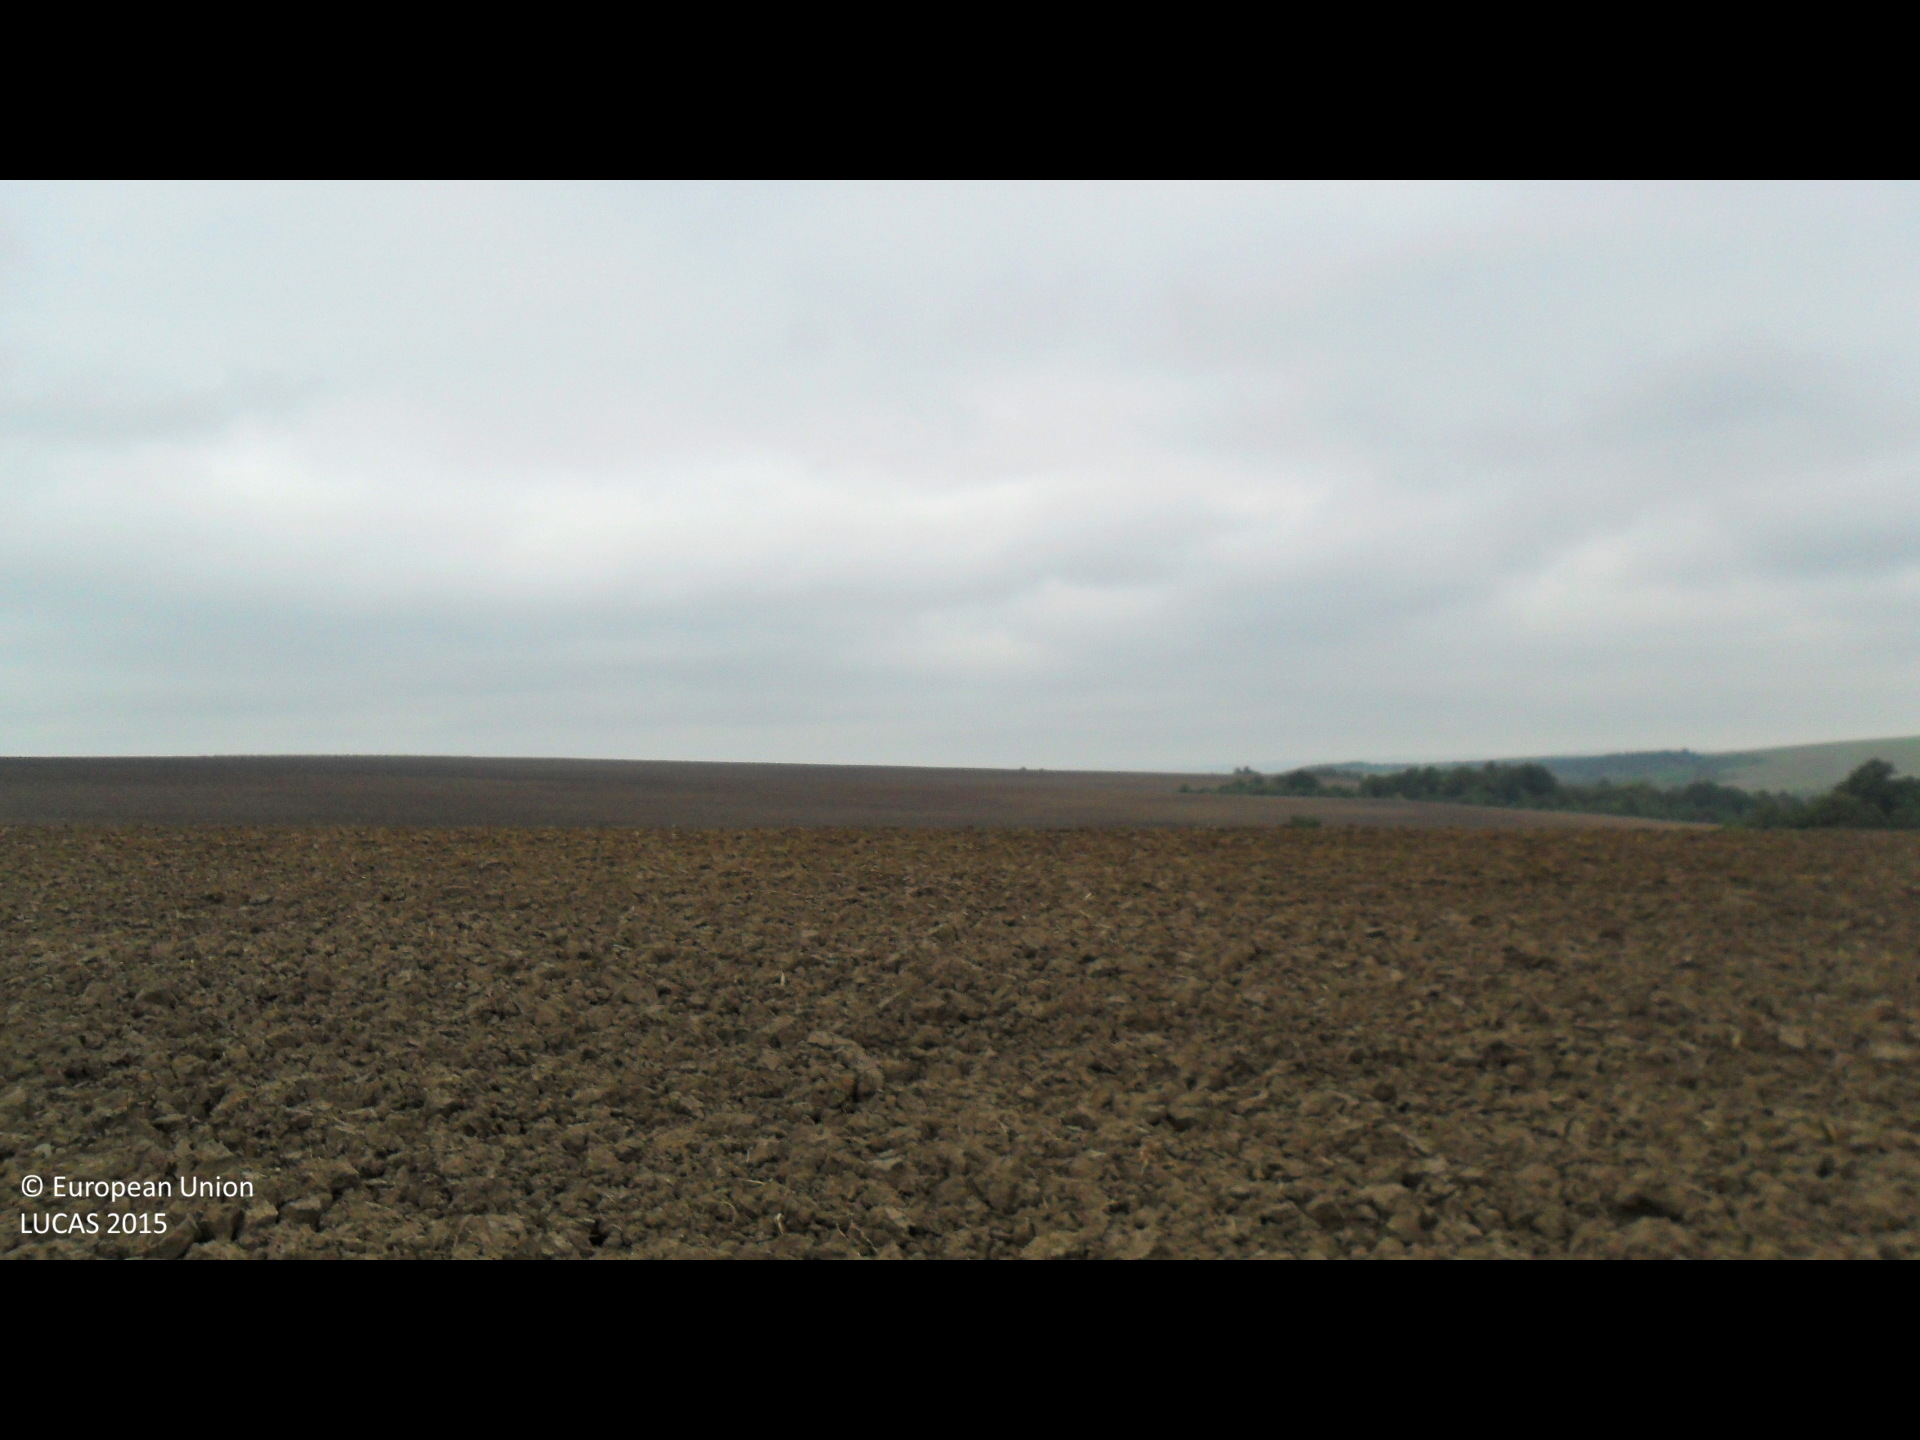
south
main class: Cropland
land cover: Maize
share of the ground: < 10 %
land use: Agriculture (excluding fallow land and kitchen gardens)
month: September
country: BG
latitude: 43.2736
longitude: 26.1737
